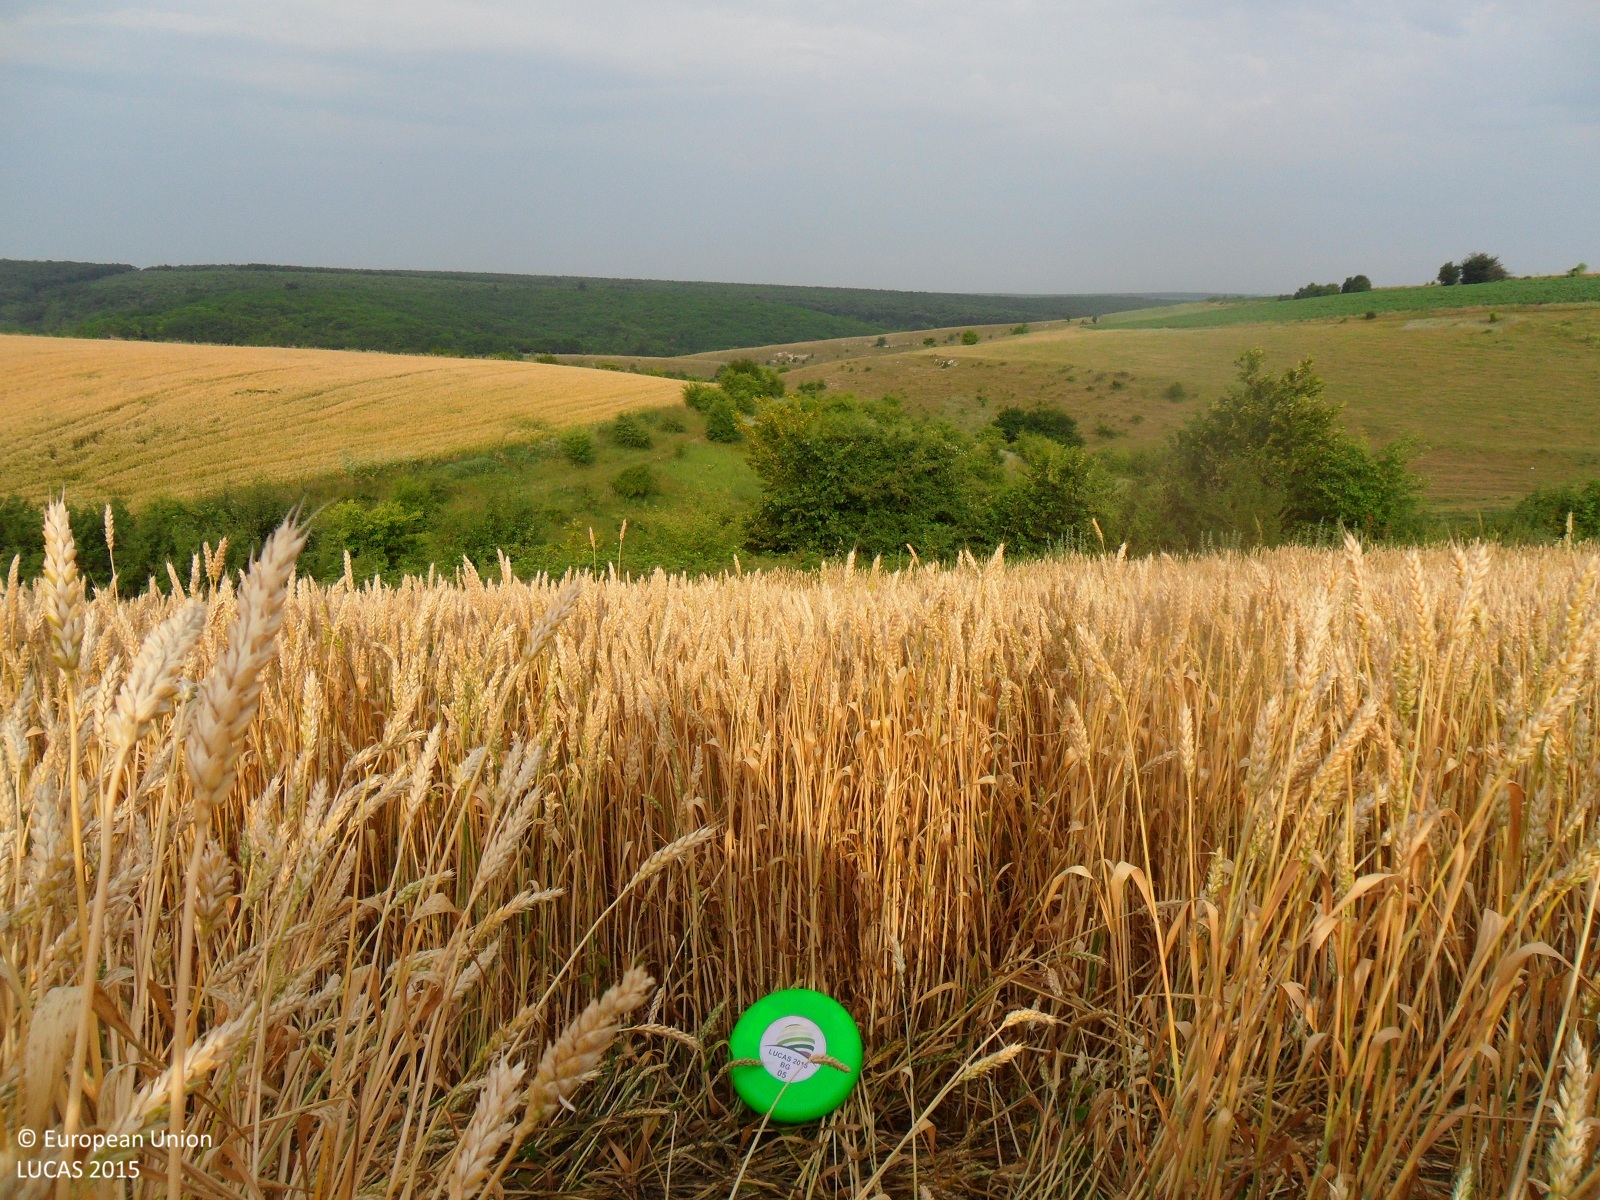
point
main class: Cropland
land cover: Common wheat
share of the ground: > 75 %
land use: Agriculture (excluding fallow land and kitchen gardens)
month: June
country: BG
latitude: 43.7779
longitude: 26.8018
